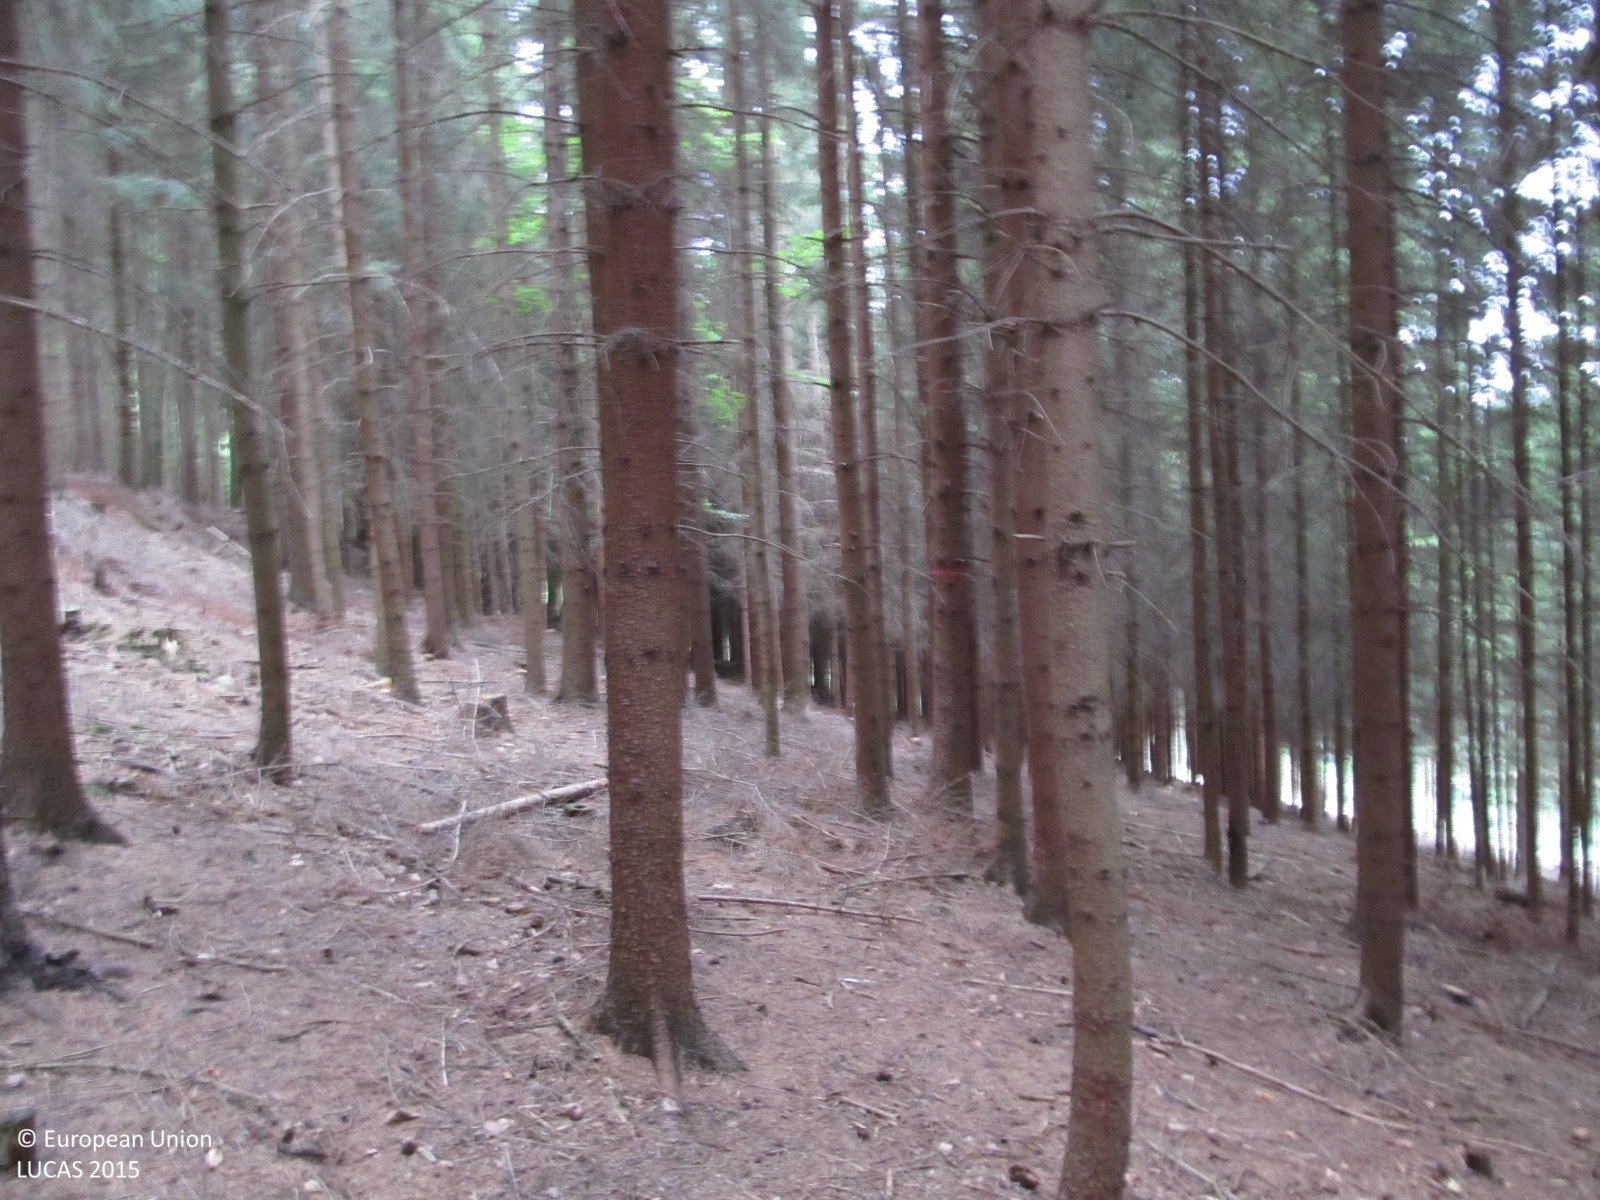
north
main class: Woodland
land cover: Spruce dominated coniferous woodland
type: hemiboreal forest and nemoral coniferous forest and mixed broadleaved-coniferous forest
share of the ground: > 75 %
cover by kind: coniferous forest trees 90 %, unconsolidated bare surface 10 %
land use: Forestry
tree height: > 5 m
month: September
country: AT
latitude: 48.3304
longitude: 15.3031
